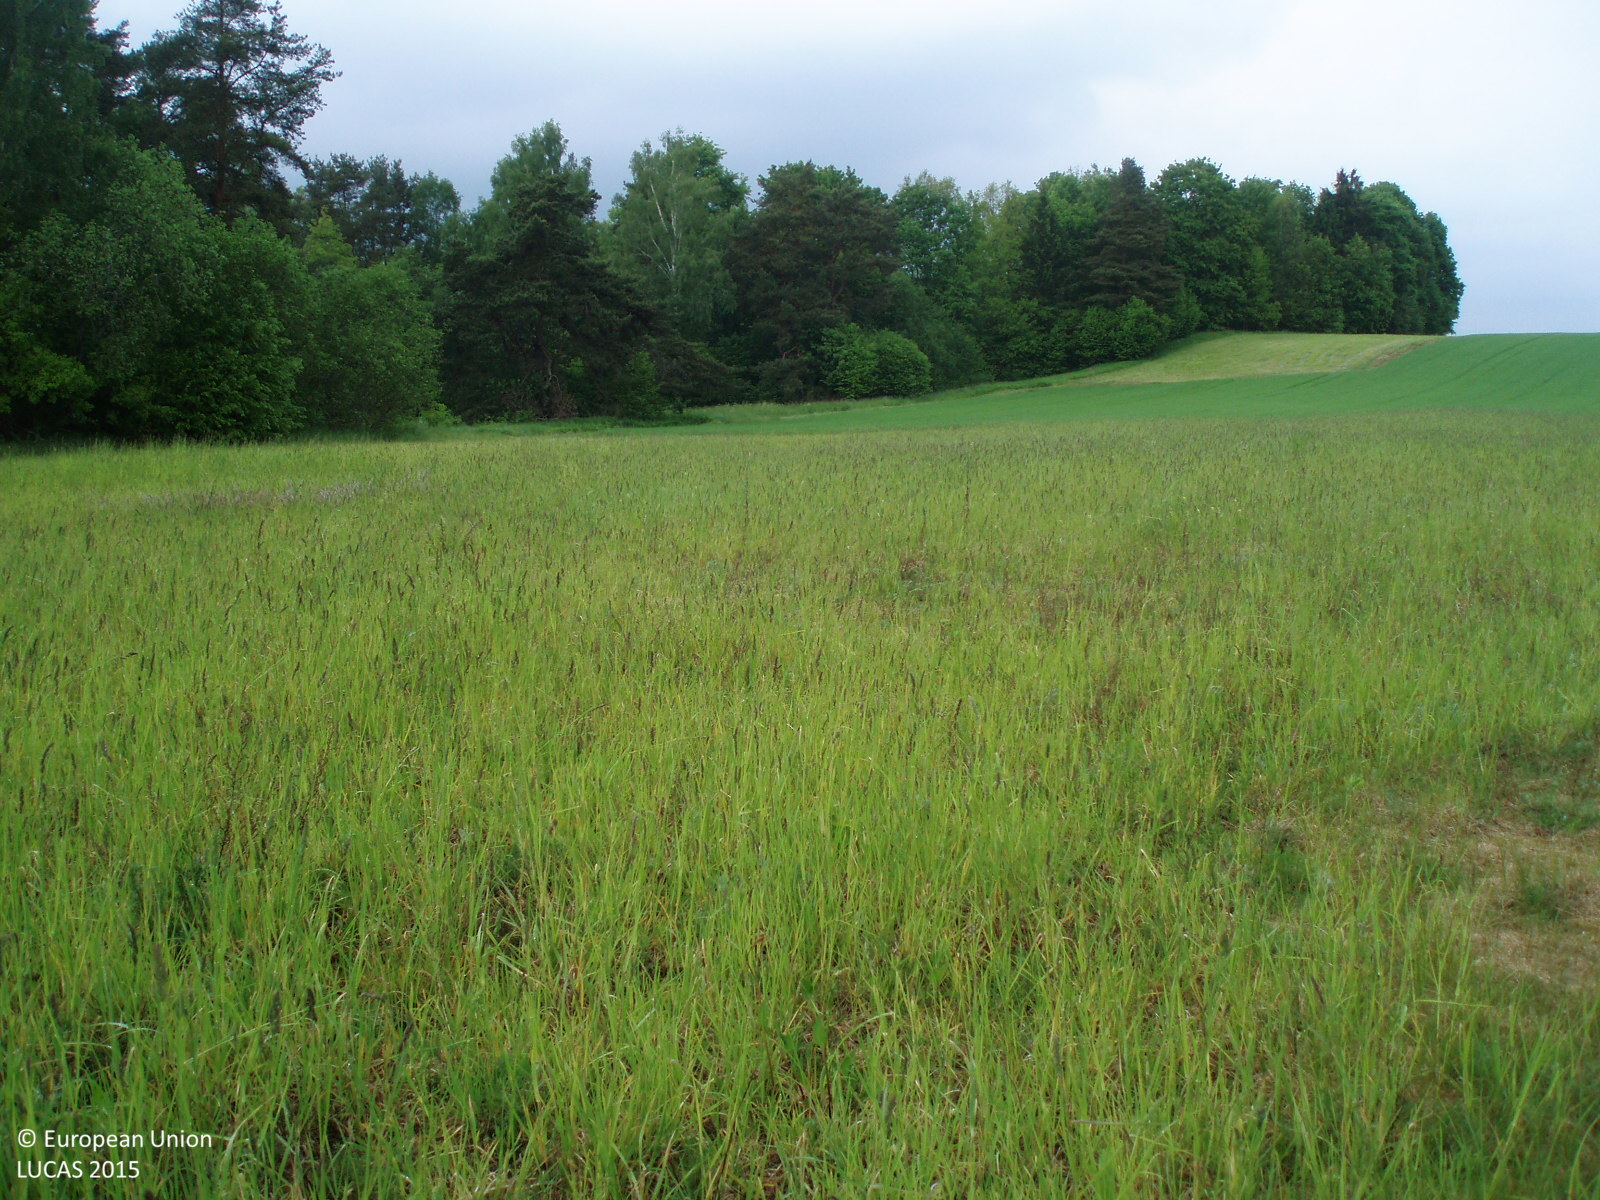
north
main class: Grassland
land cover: Grassland without tree/shrub cover
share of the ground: > 75 %
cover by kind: herbaceous plants 70 %, lichens and mosses 30 %
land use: Agriculture (excluding fallow land and kitchen gardens)
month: May
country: LT
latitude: 56.1531
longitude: 22.5356
